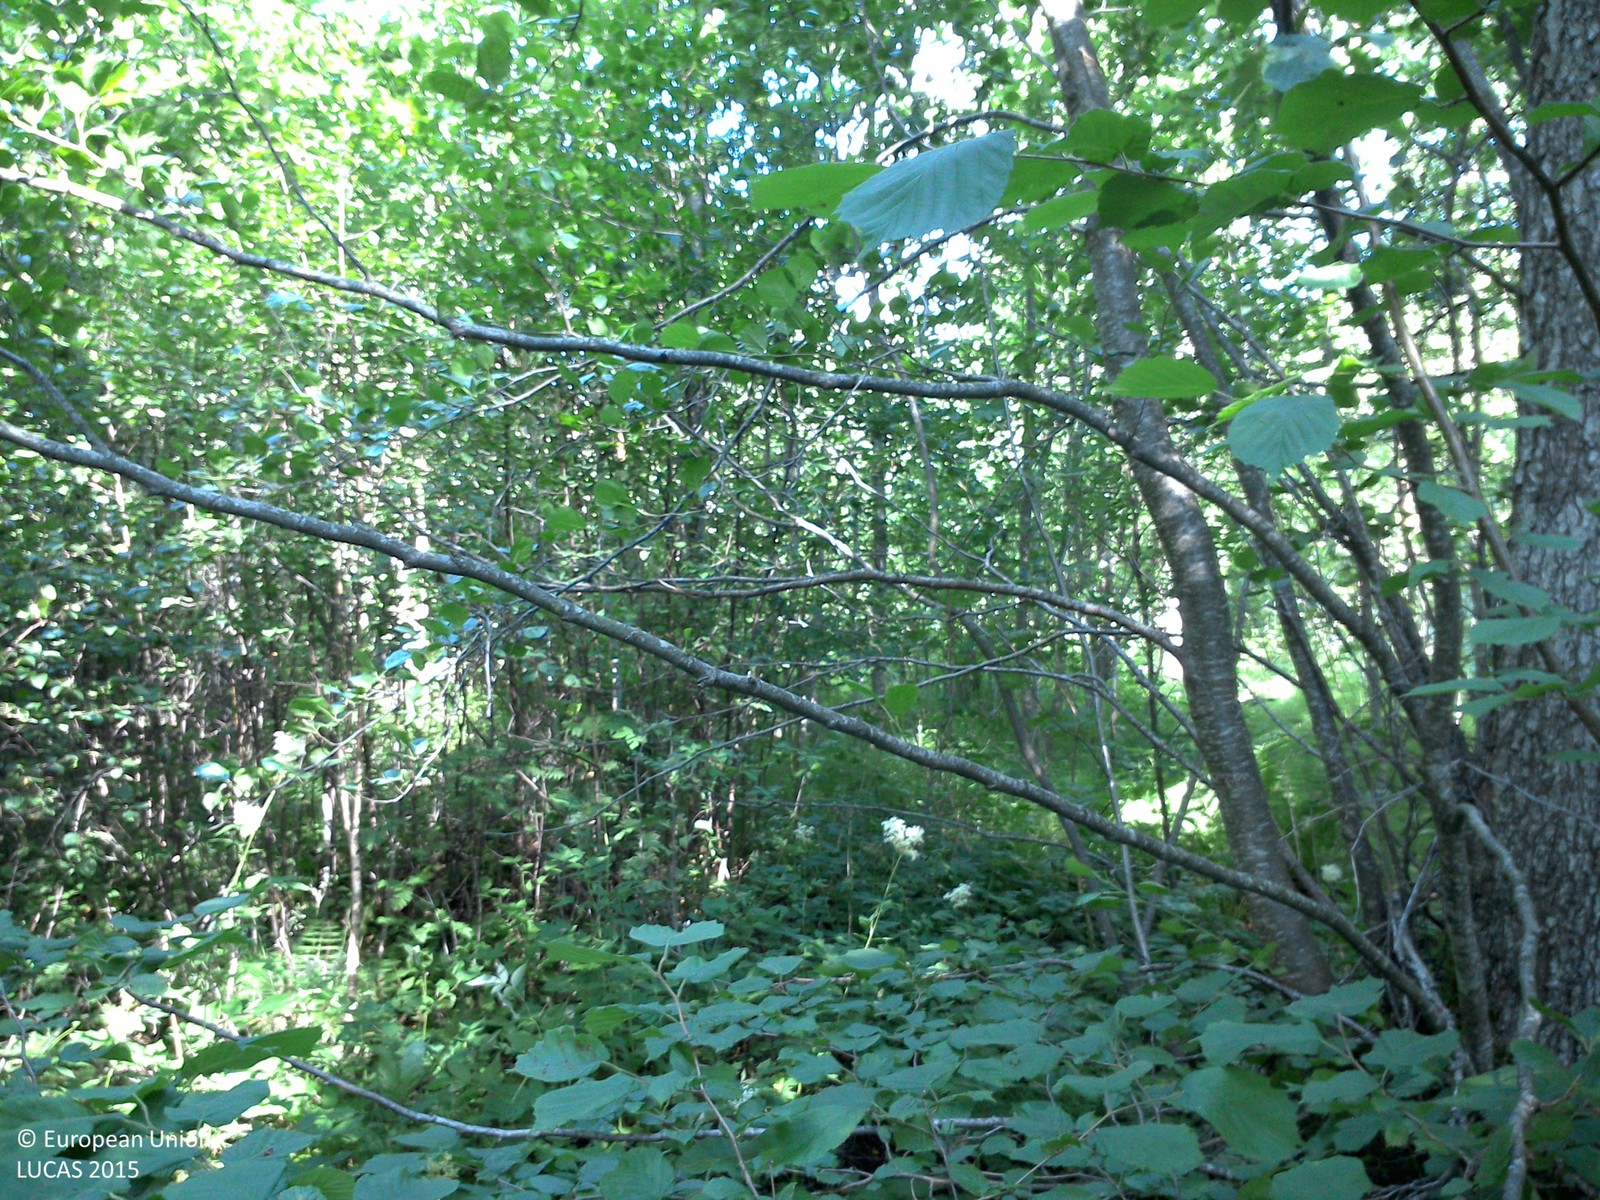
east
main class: Woodland
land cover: Broadleaved woodland
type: boreal forest
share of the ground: > 75 %
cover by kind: broadleaved forest trees 80 %, herbaceous plants 20 %
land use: Forestry
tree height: > 5 m
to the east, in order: Broadleaved woodland; Ditches and canals; Grass margins; Paved roads, cycling and walking lanes; Grass margins; Ditches and canals; Spruce dominated coniferous woodland; Tracks; Broadleaved woodland; Ditches and canals; Broadleaved woodland; Paved roads, cycling and walking lanes; Spruce dominated coniferous woodland
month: July
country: SE
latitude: 57.9675
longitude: 14.9140
